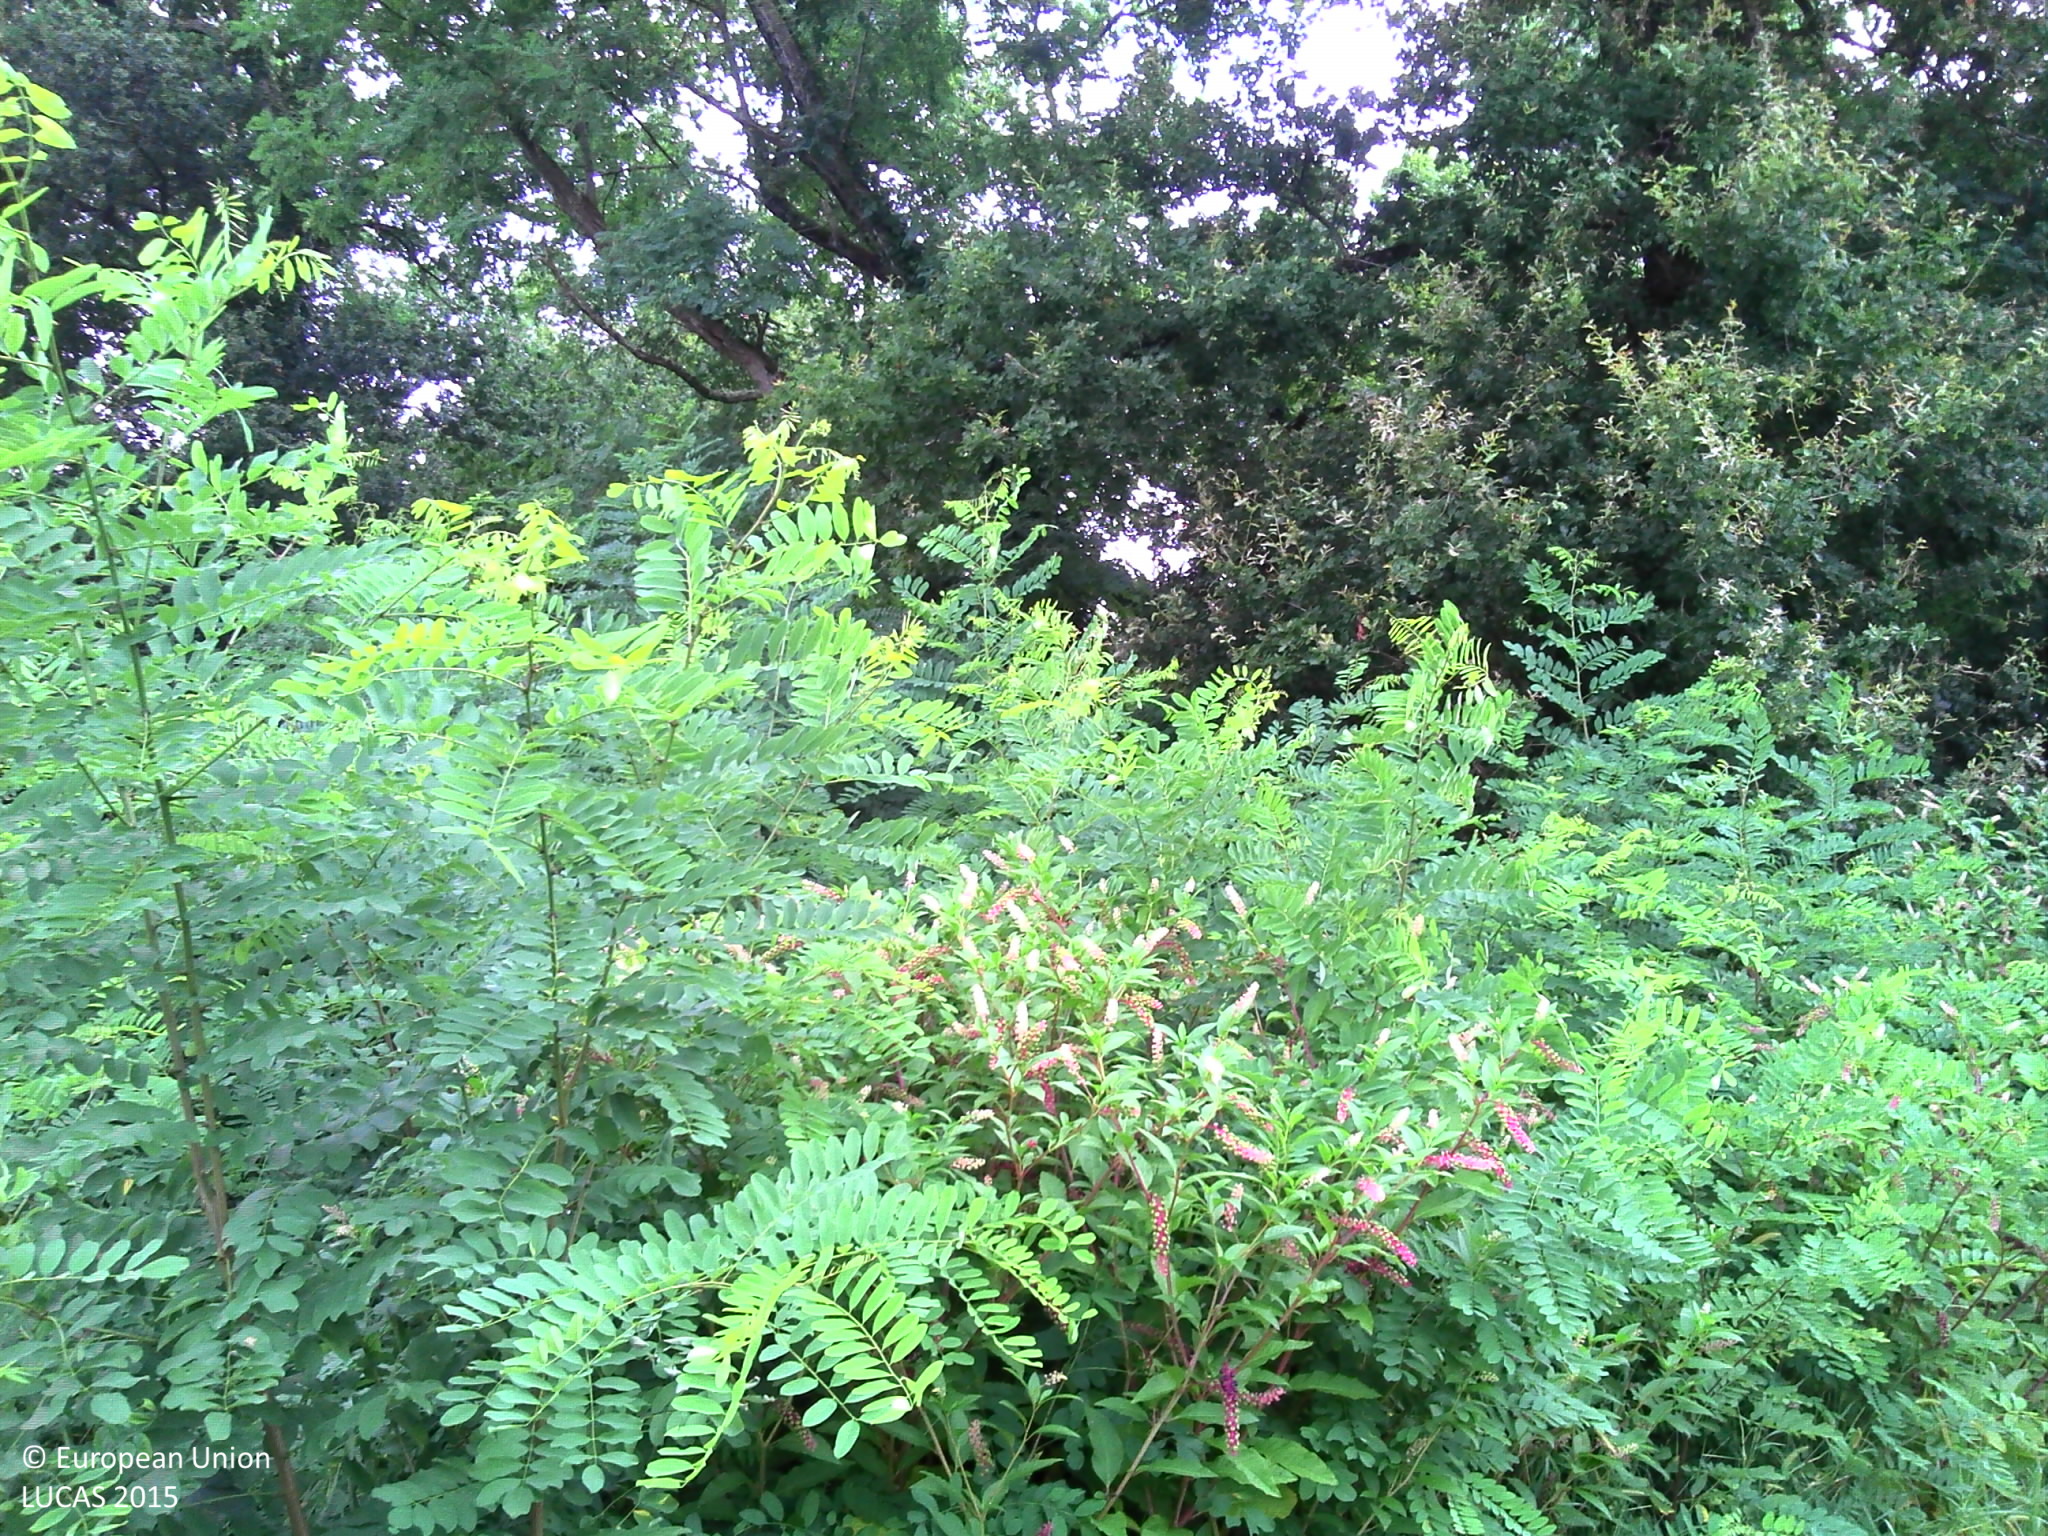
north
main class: Cropland
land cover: Maize
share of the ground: > 75 %
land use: Agriculture (excluding fallow land and kitchen gardens)
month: August
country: FR
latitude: 43.6561
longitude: -0.9882
